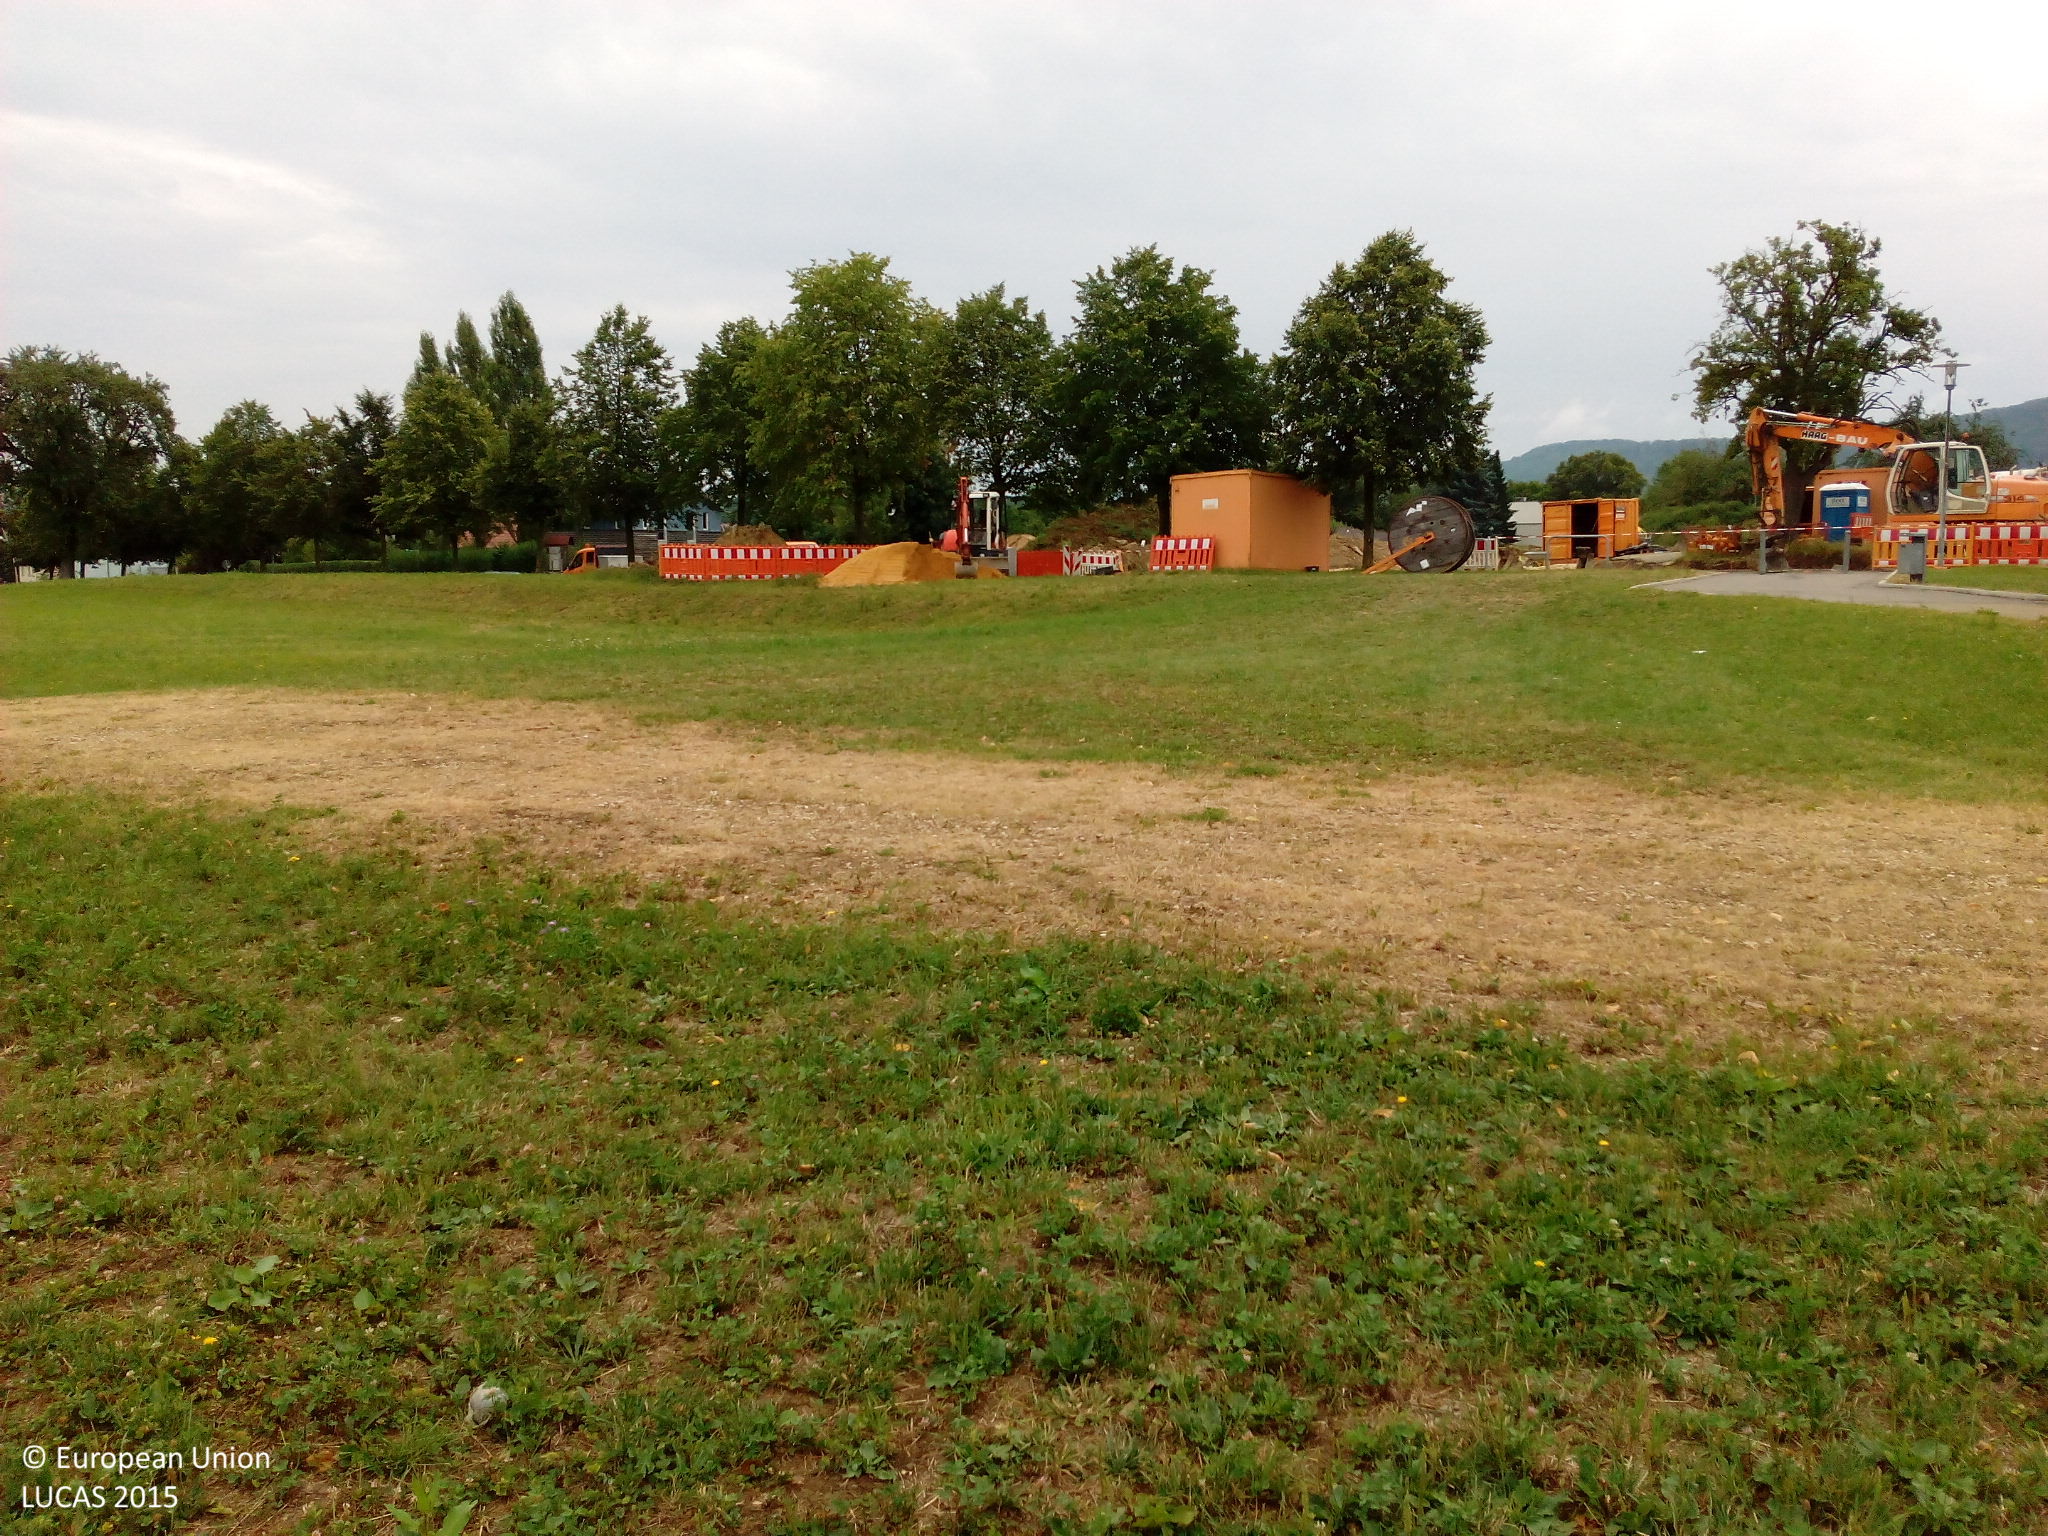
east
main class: Grassland
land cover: Grassland without tree/shrub cover
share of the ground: > 75 %
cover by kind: herbaceous plants 90 %, unconsolidated bare surface 10 %
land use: Amenities, museums, leisure
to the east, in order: Grassland without tree/shrub cover; Other bare soil; Grassland without tree/shrub cover; Lines of trees; Paved roads, cycling and walking lanes; Grass margins; Paved roads, cycling and walking lanes; Other bare soil; Artificial constructions in urban areas
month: July
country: DE
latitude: 48.8173
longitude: 9.9592
